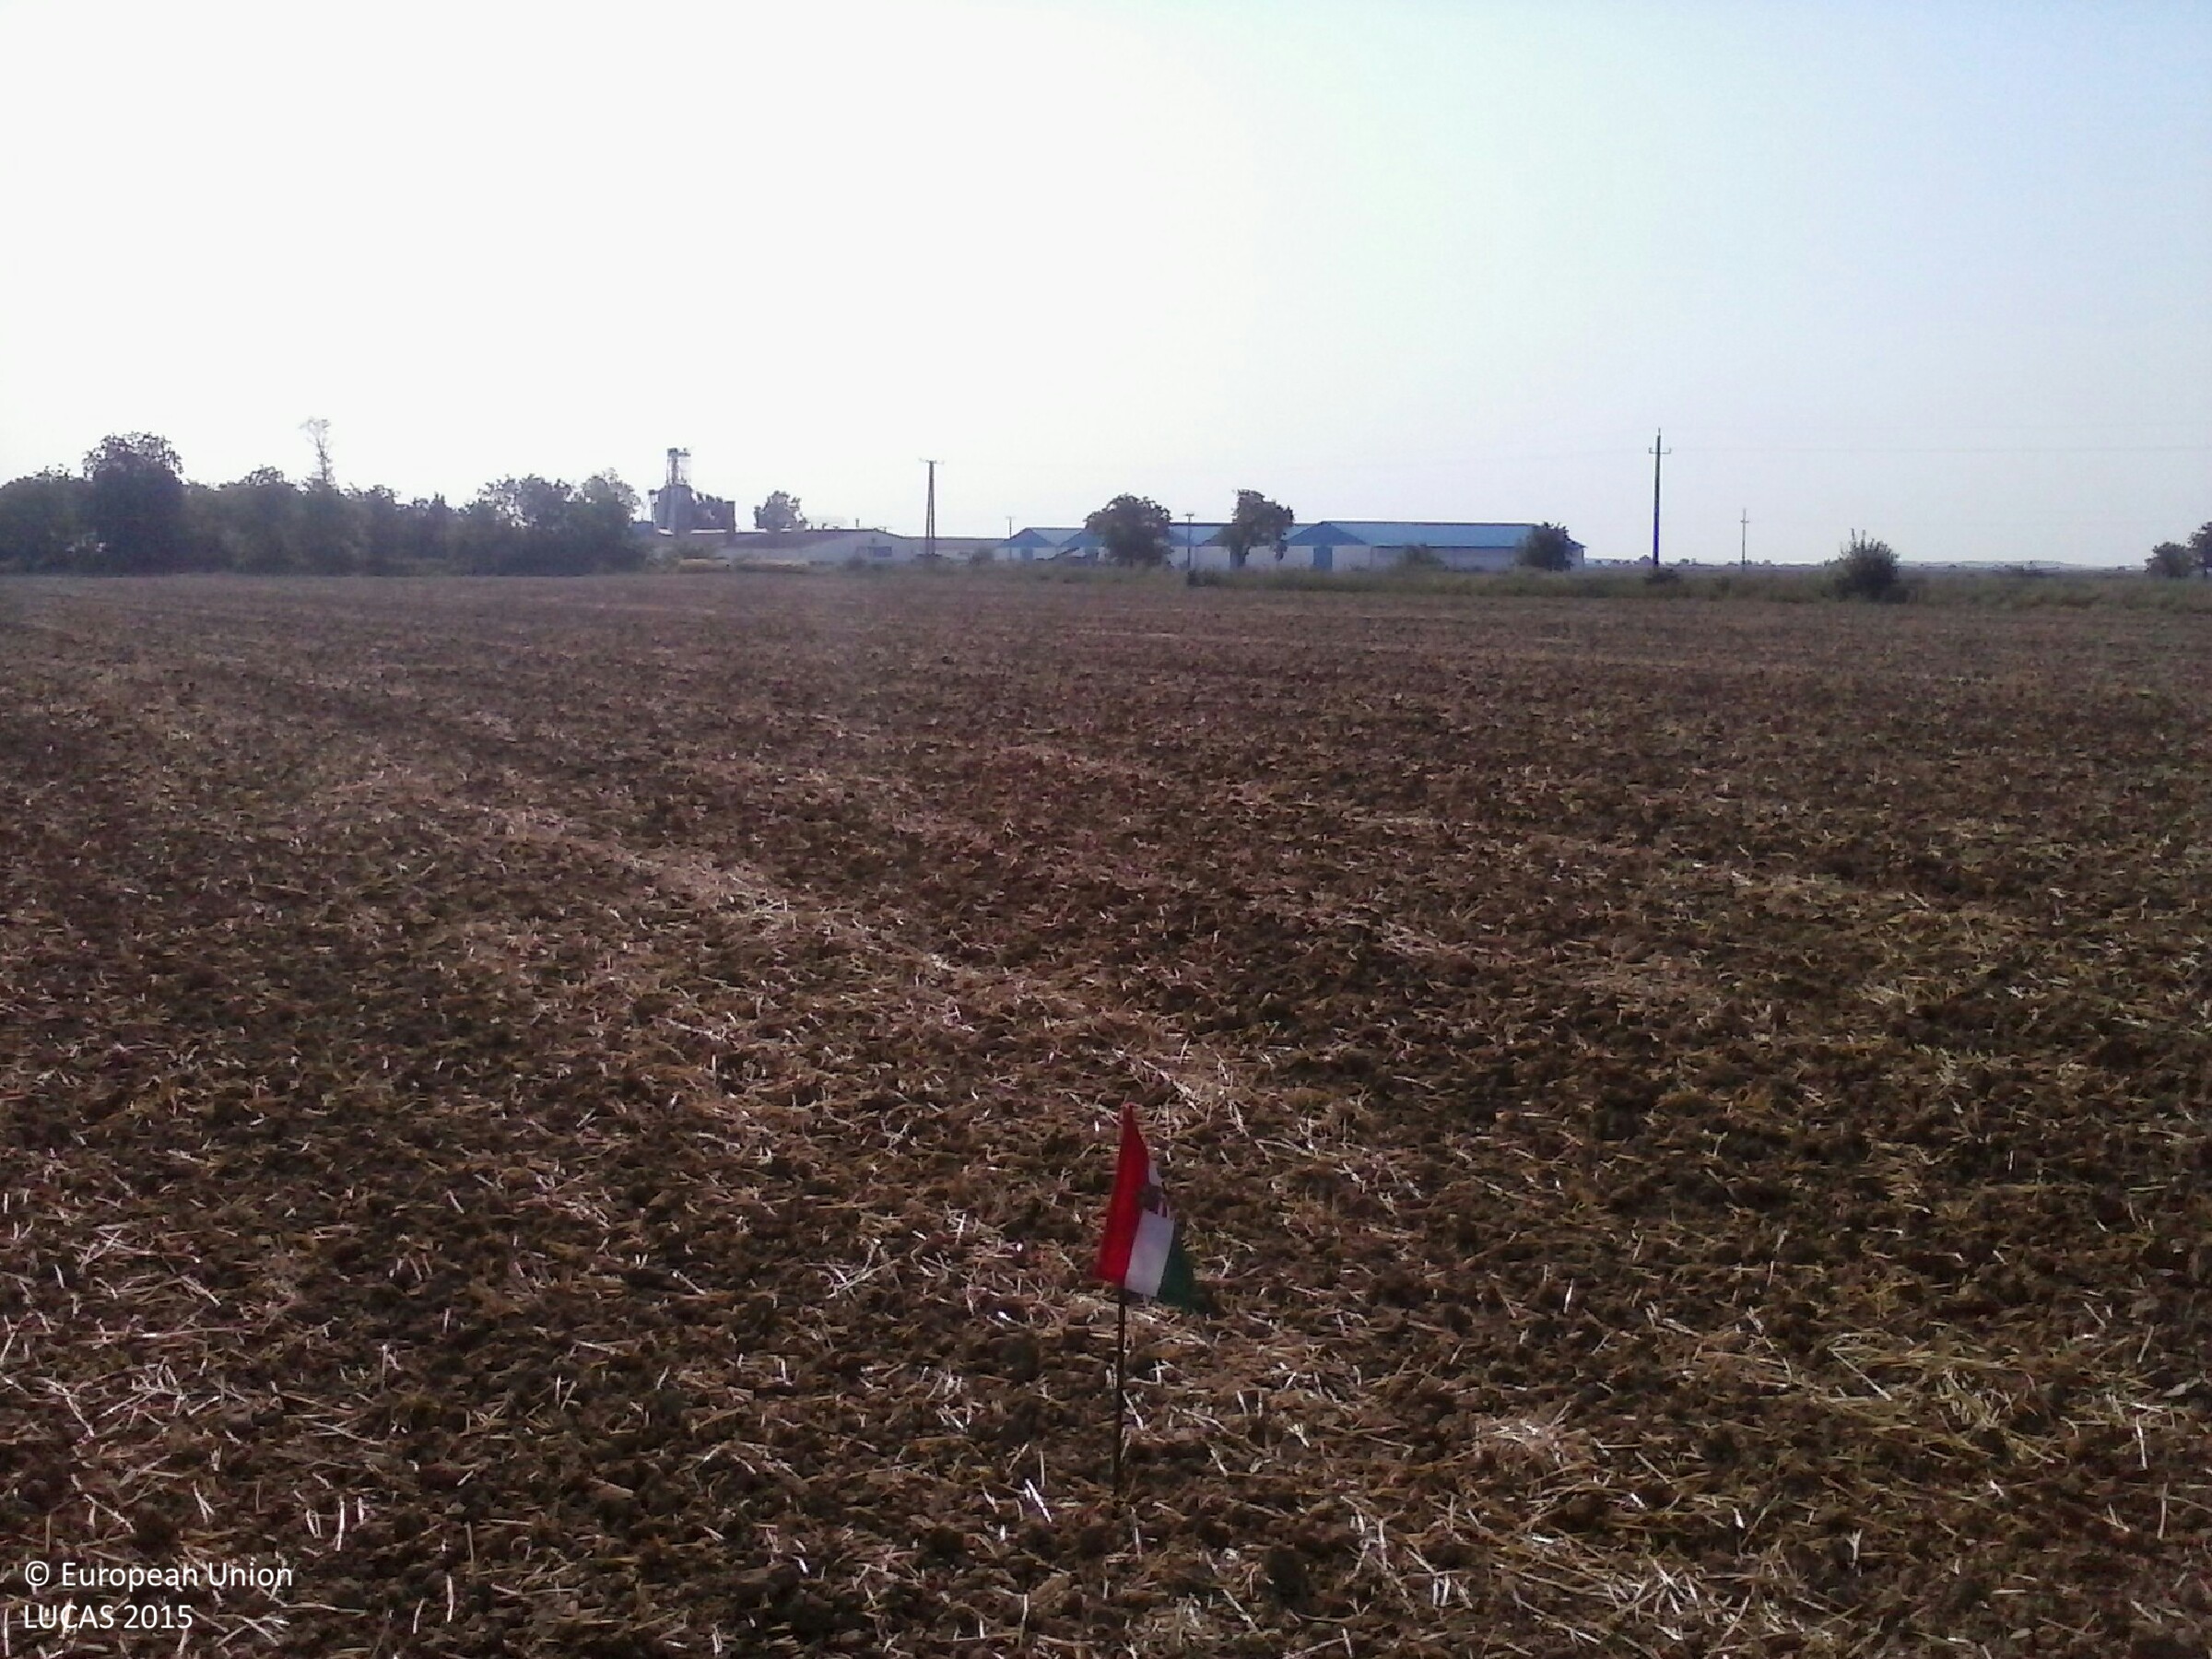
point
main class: Cropland
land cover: Common wheat
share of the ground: < 10 %
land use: Agriculture (excluding fallow land and kitchen gardens)
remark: Harvested field
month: August
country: HU
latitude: 46.0227
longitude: 17.8979
